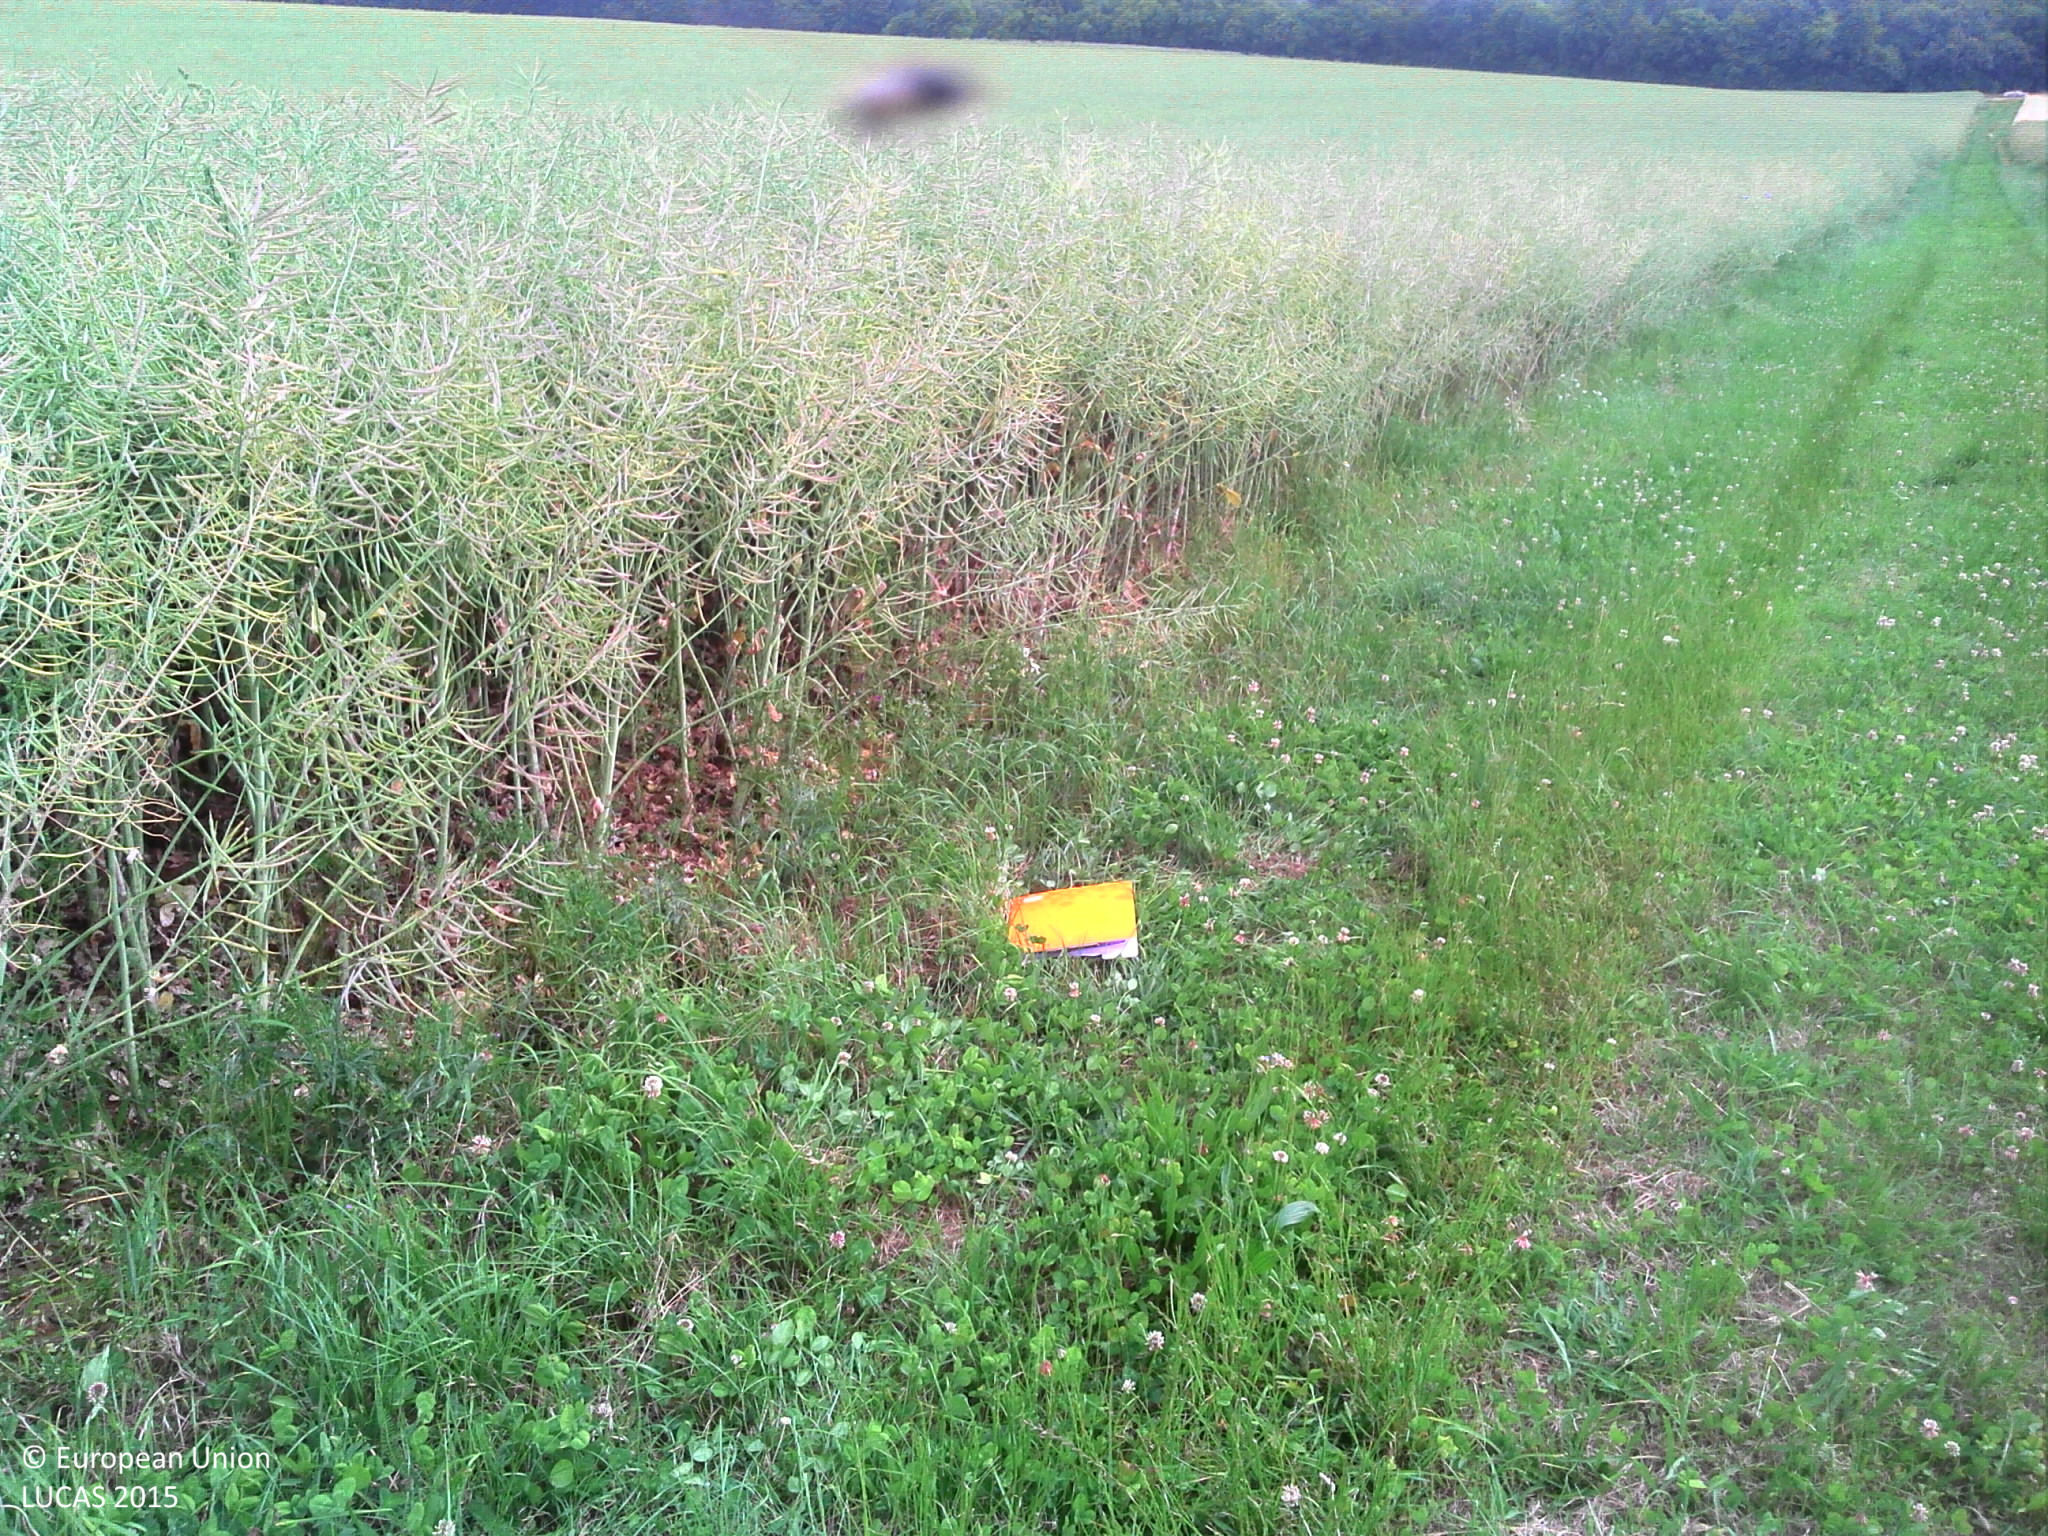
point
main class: Cropland
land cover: Rape and turnip rape
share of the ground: > 75 %
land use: Agriculture (excluding fallow land and kitchen gardens)
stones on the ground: 10 - 25 %
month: June
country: FR
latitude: 48.3788
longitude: 4.9624
